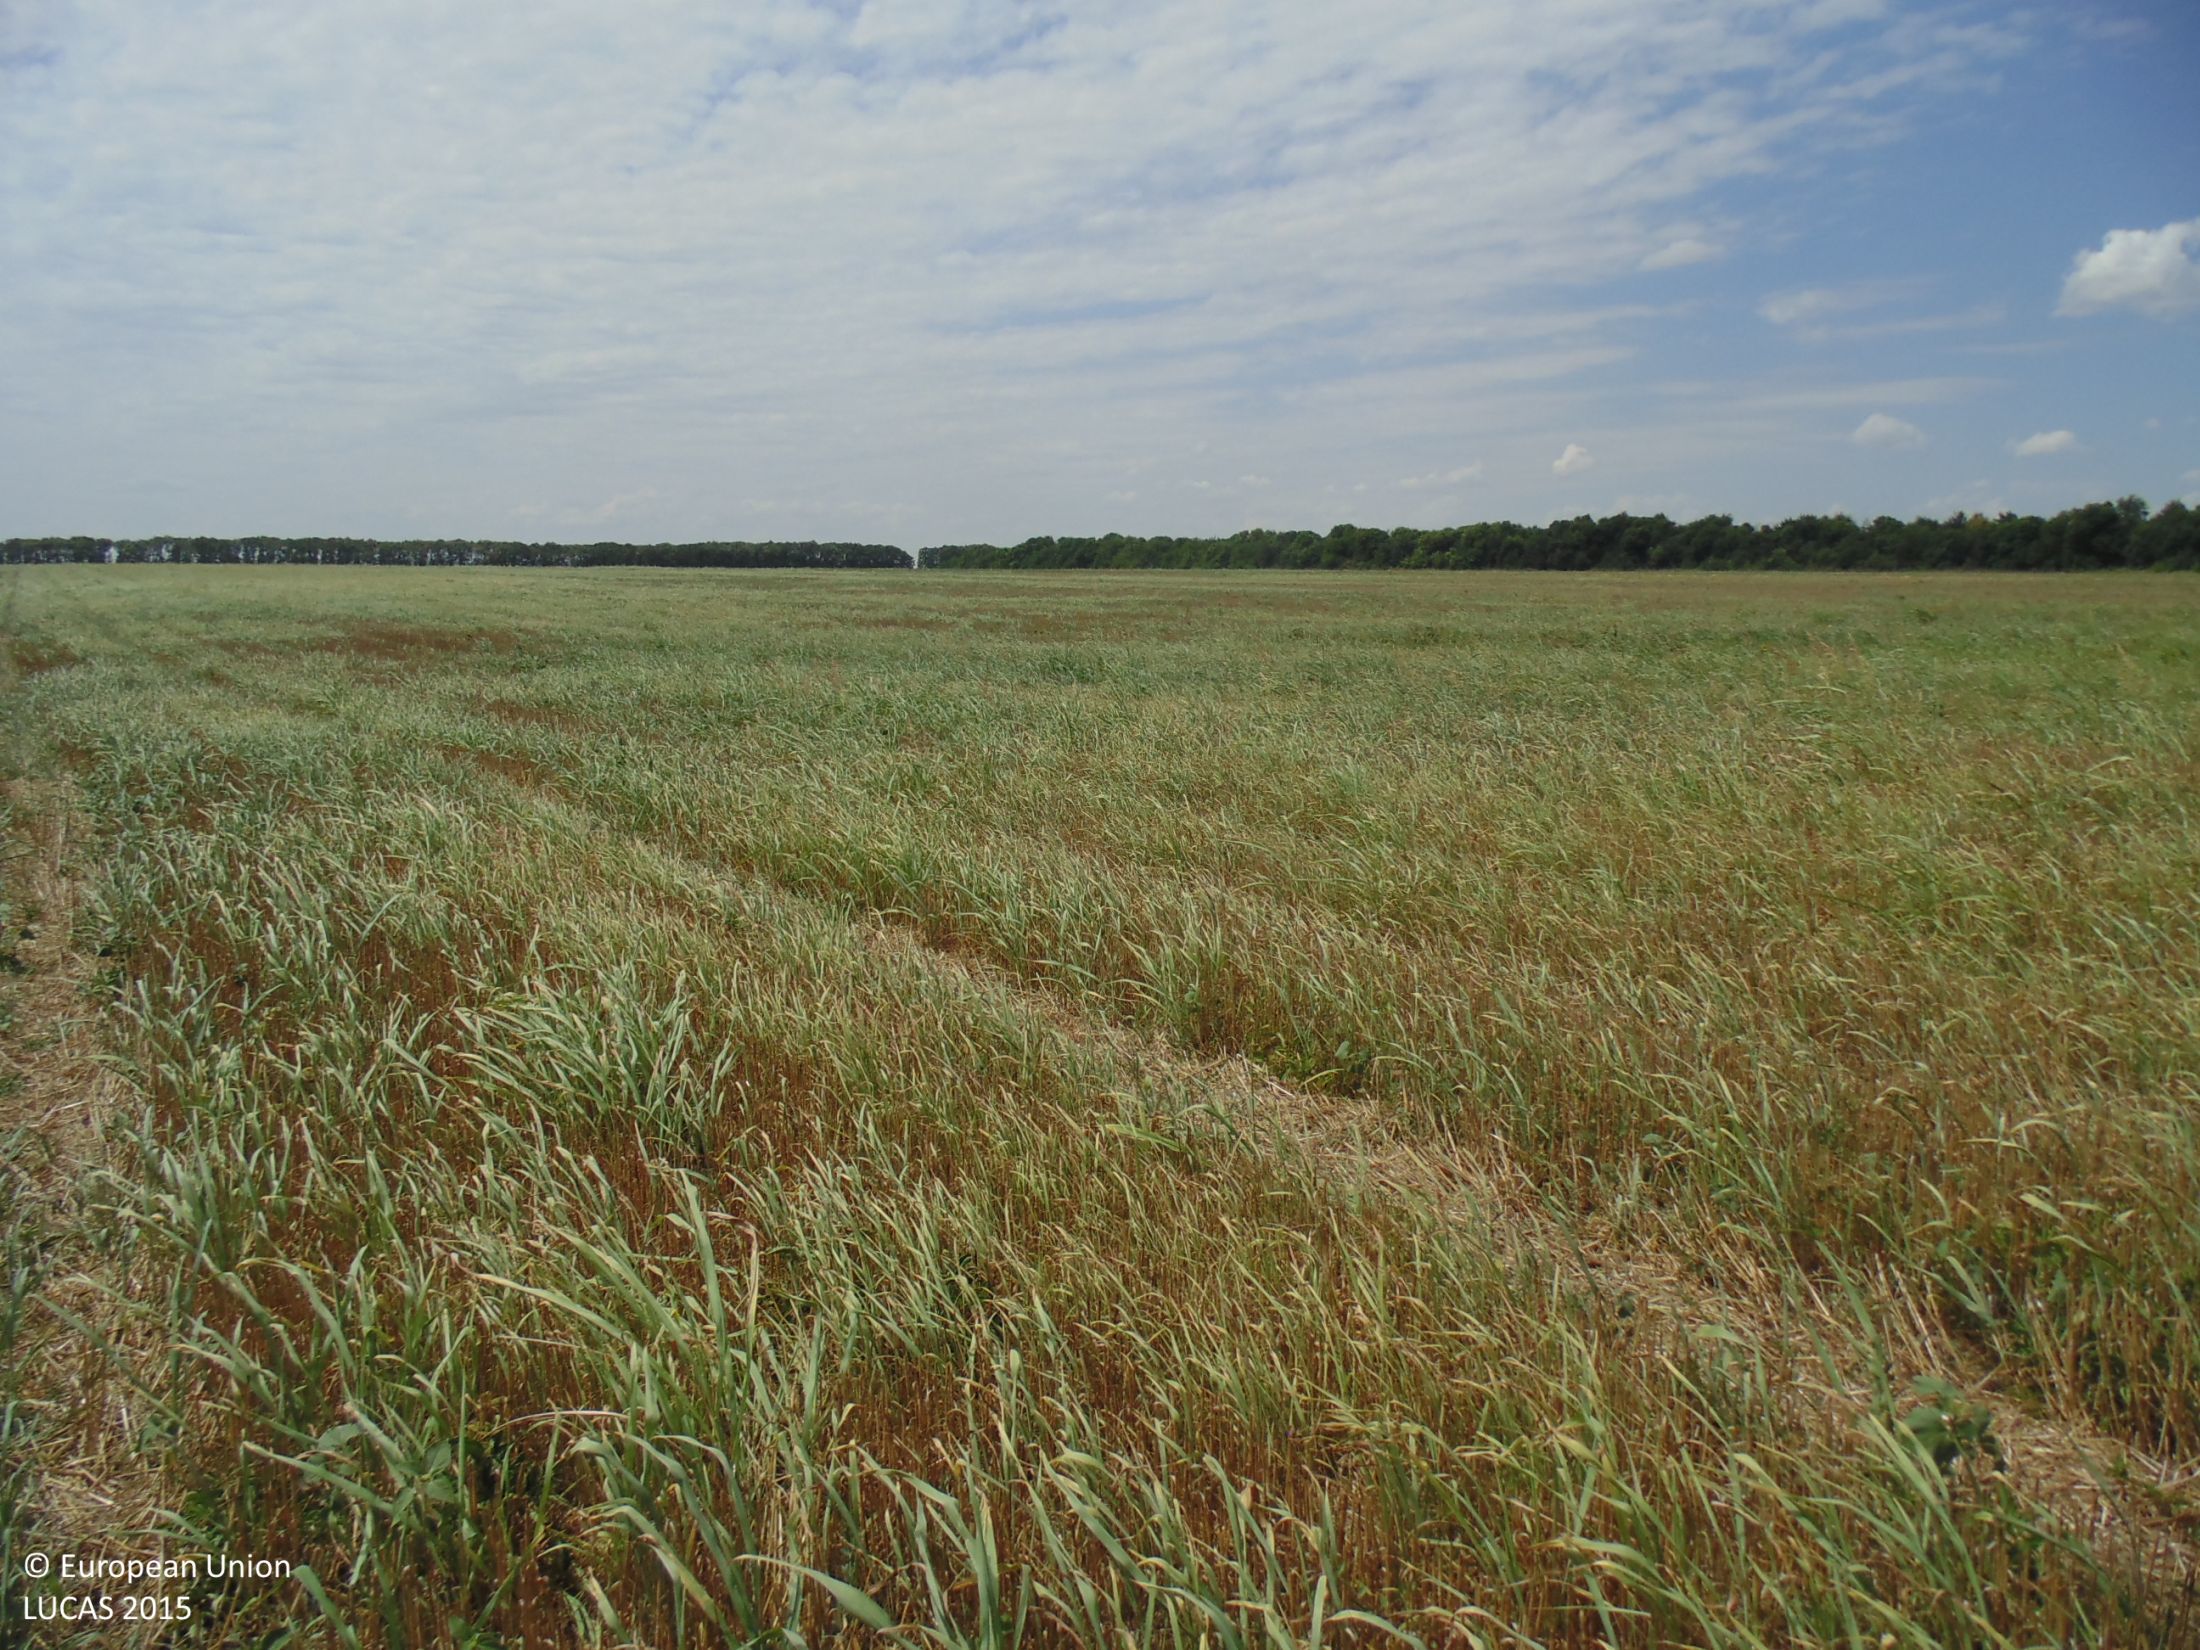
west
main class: Cropland
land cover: Common wheat
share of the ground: 50 - 75 %
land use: Agriculture (excluding fallow land and kitchen gardens)
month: August
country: BG
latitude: 43.6048
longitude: 28.2294
